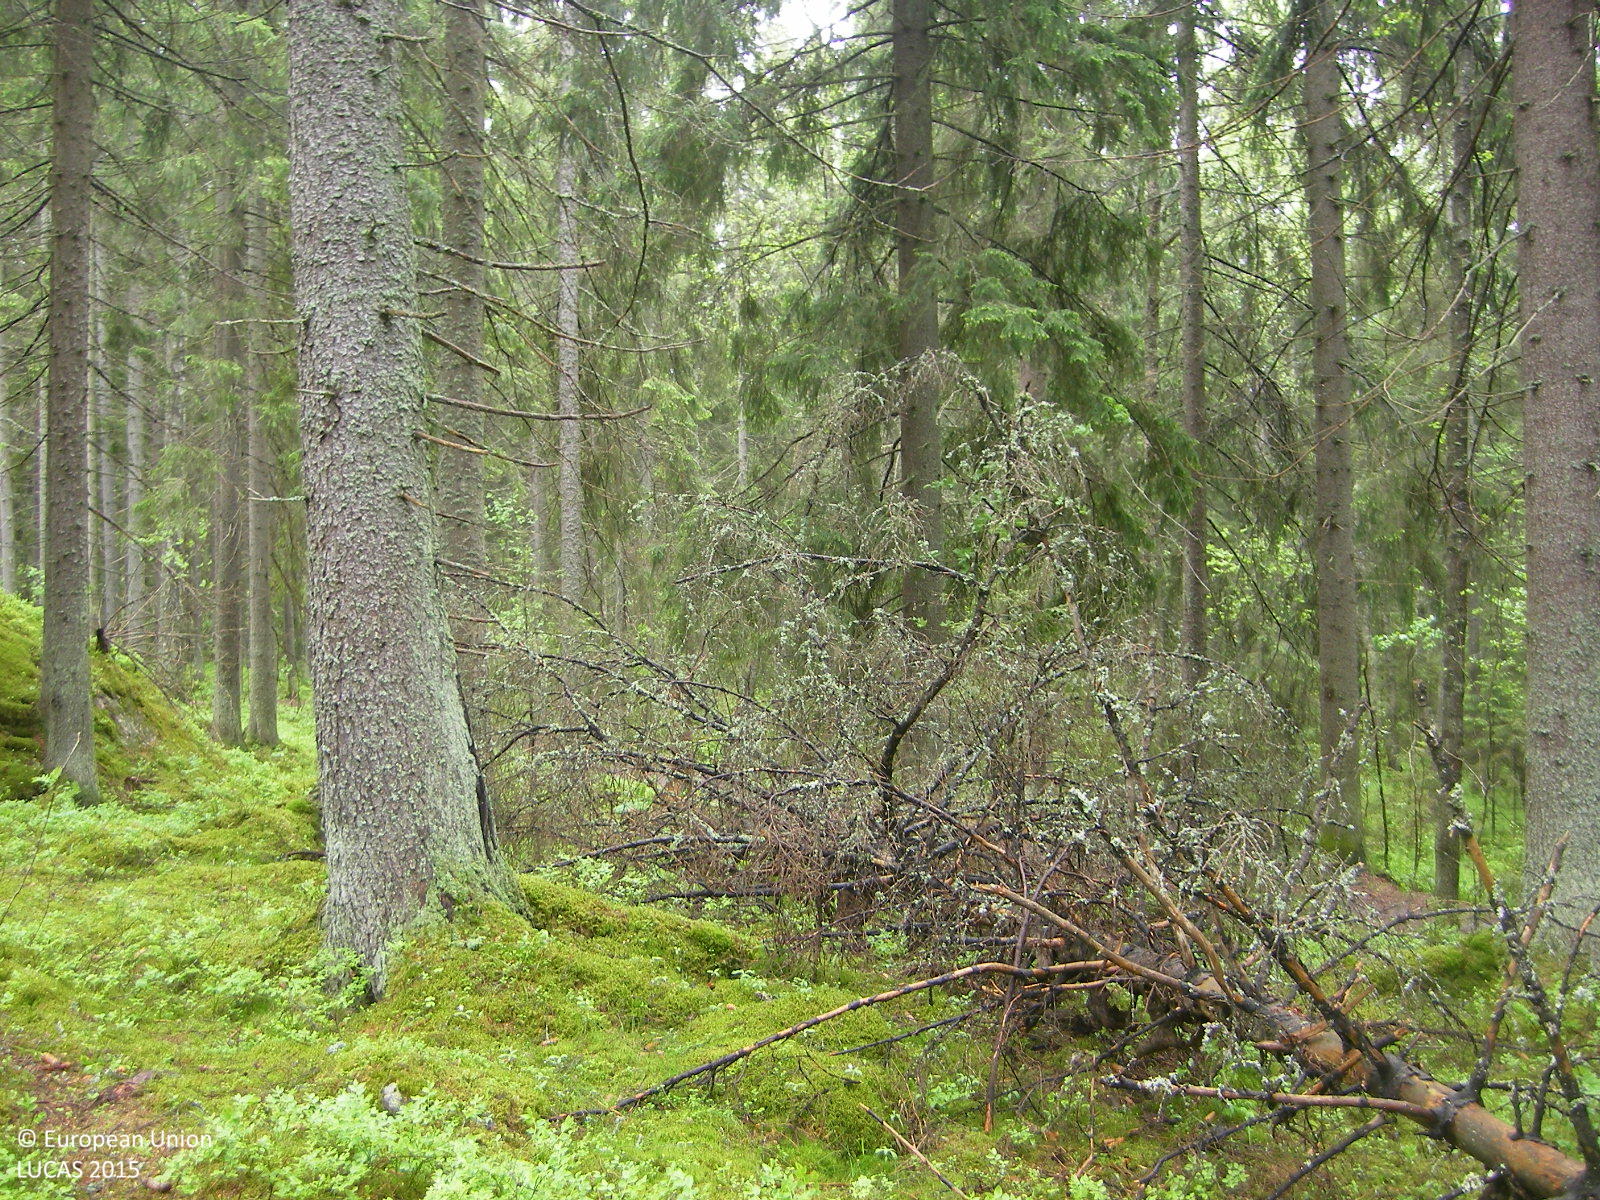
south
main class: Woodland
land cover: Spruce dominated coniferous woodland
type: boreal forest
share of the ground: > 75 %
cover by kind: coniferous forest trees 75 %, shrubs 15 %, lichens and mosses 10 %
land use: Amenities, museums, leisure
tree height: > 5 m
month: June
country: FI
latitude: 60.3237
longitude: 24.6881
